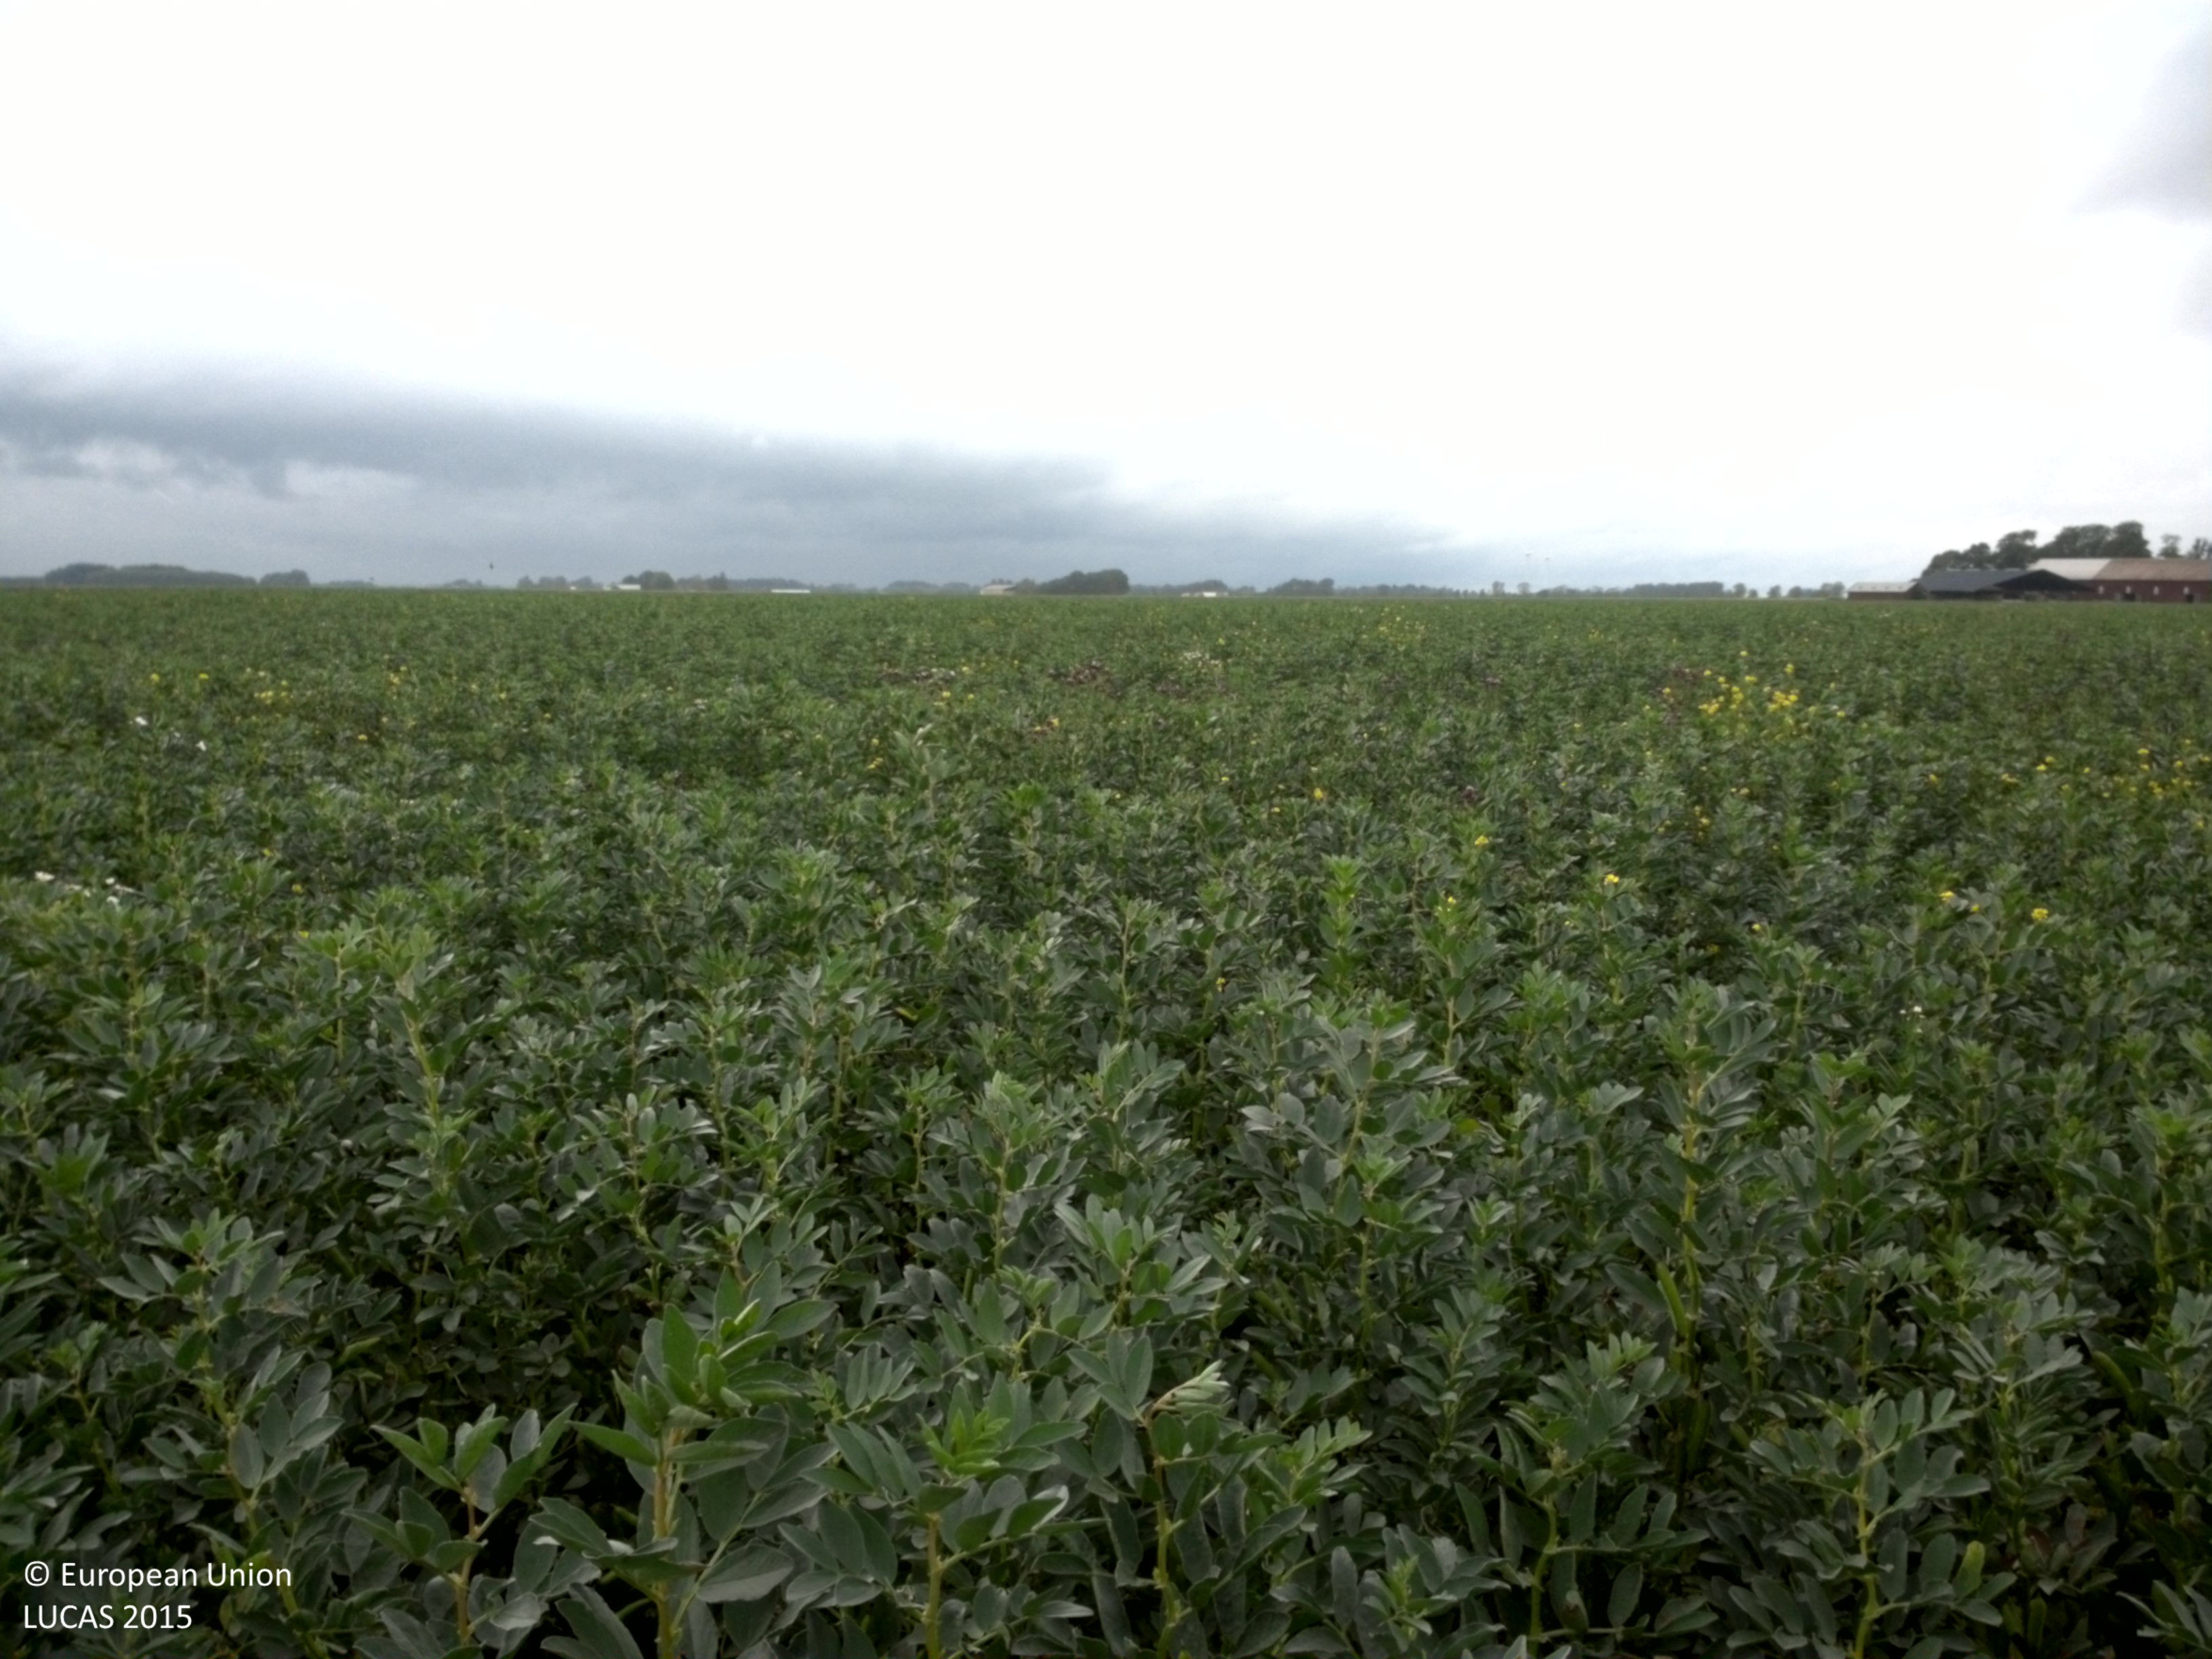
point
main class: Cropland
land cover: Dry pulses
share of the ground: > 75 %
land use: Agriculture (excluding fallow land and kitchen gardens)
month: July
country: SE
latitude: 58.4139
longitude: 13.2636
